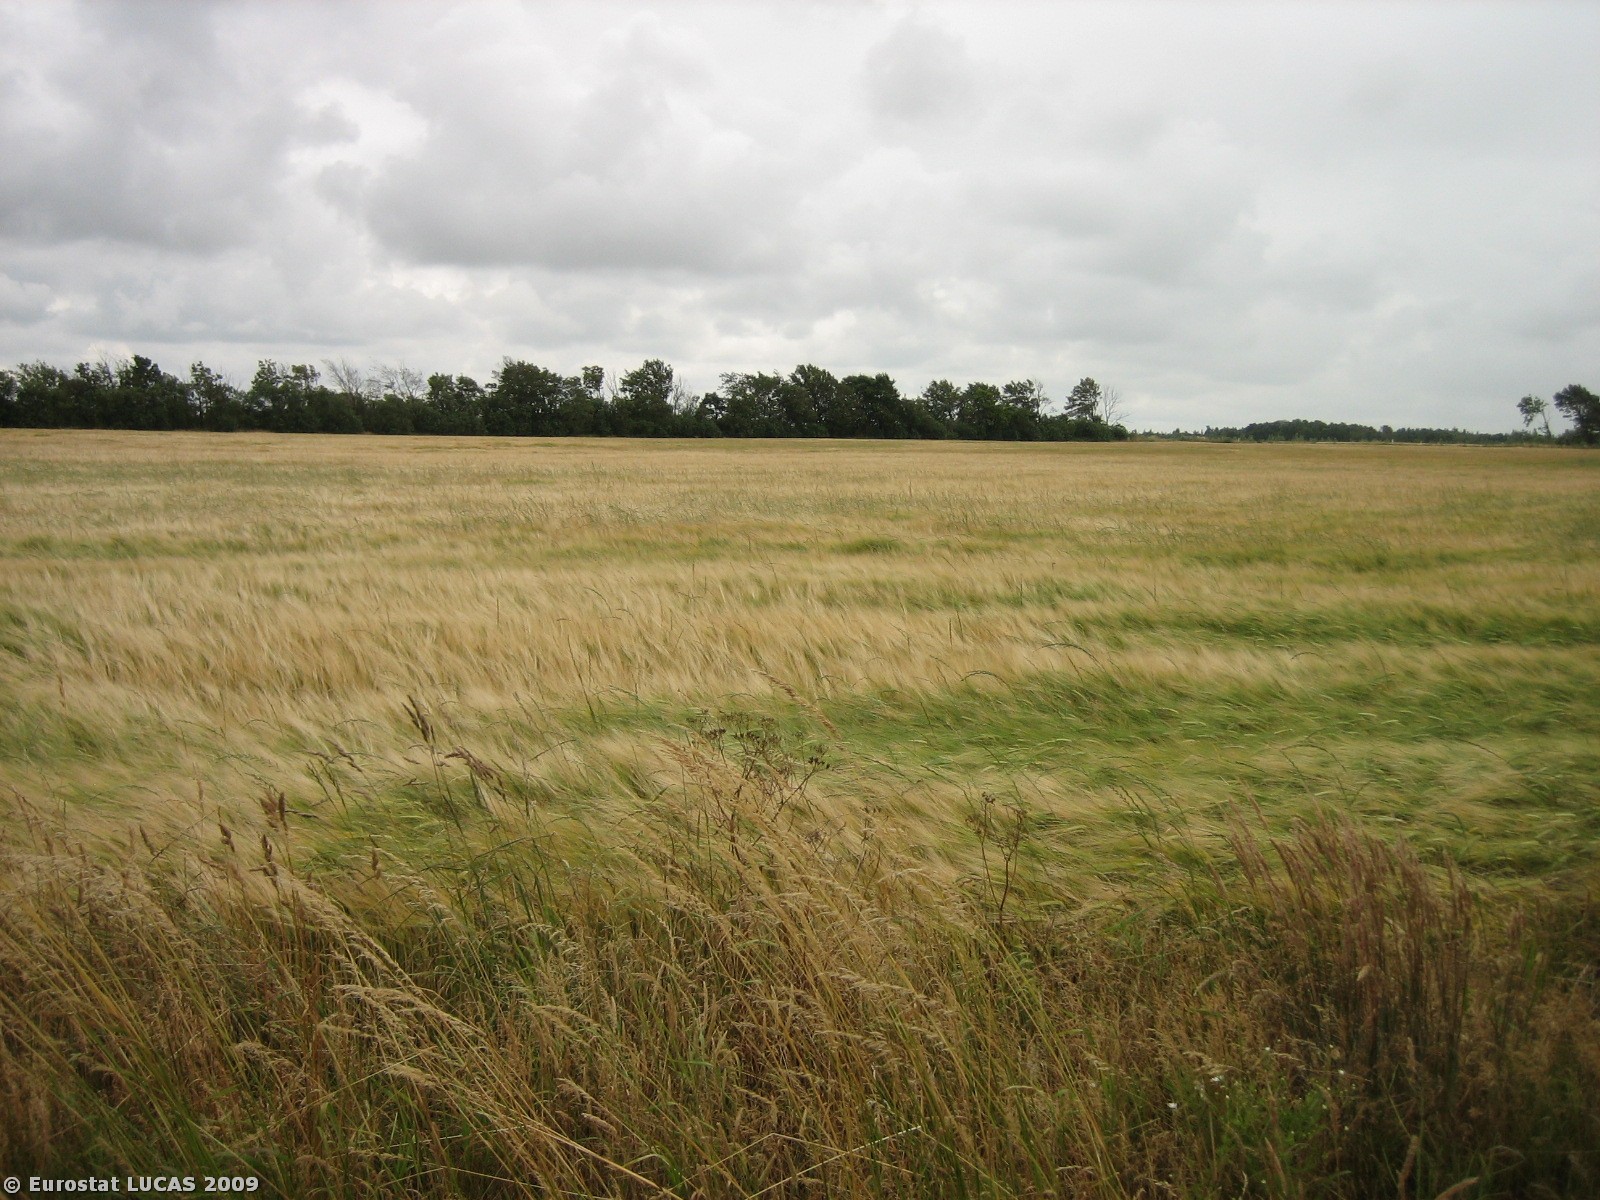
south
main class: Cropland
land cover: Barley
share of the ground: > 75 %
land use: Agriculture (excluding fallow land and kitchen gardens)
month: July
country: DK
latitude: 55.8559
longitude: 8.5477
